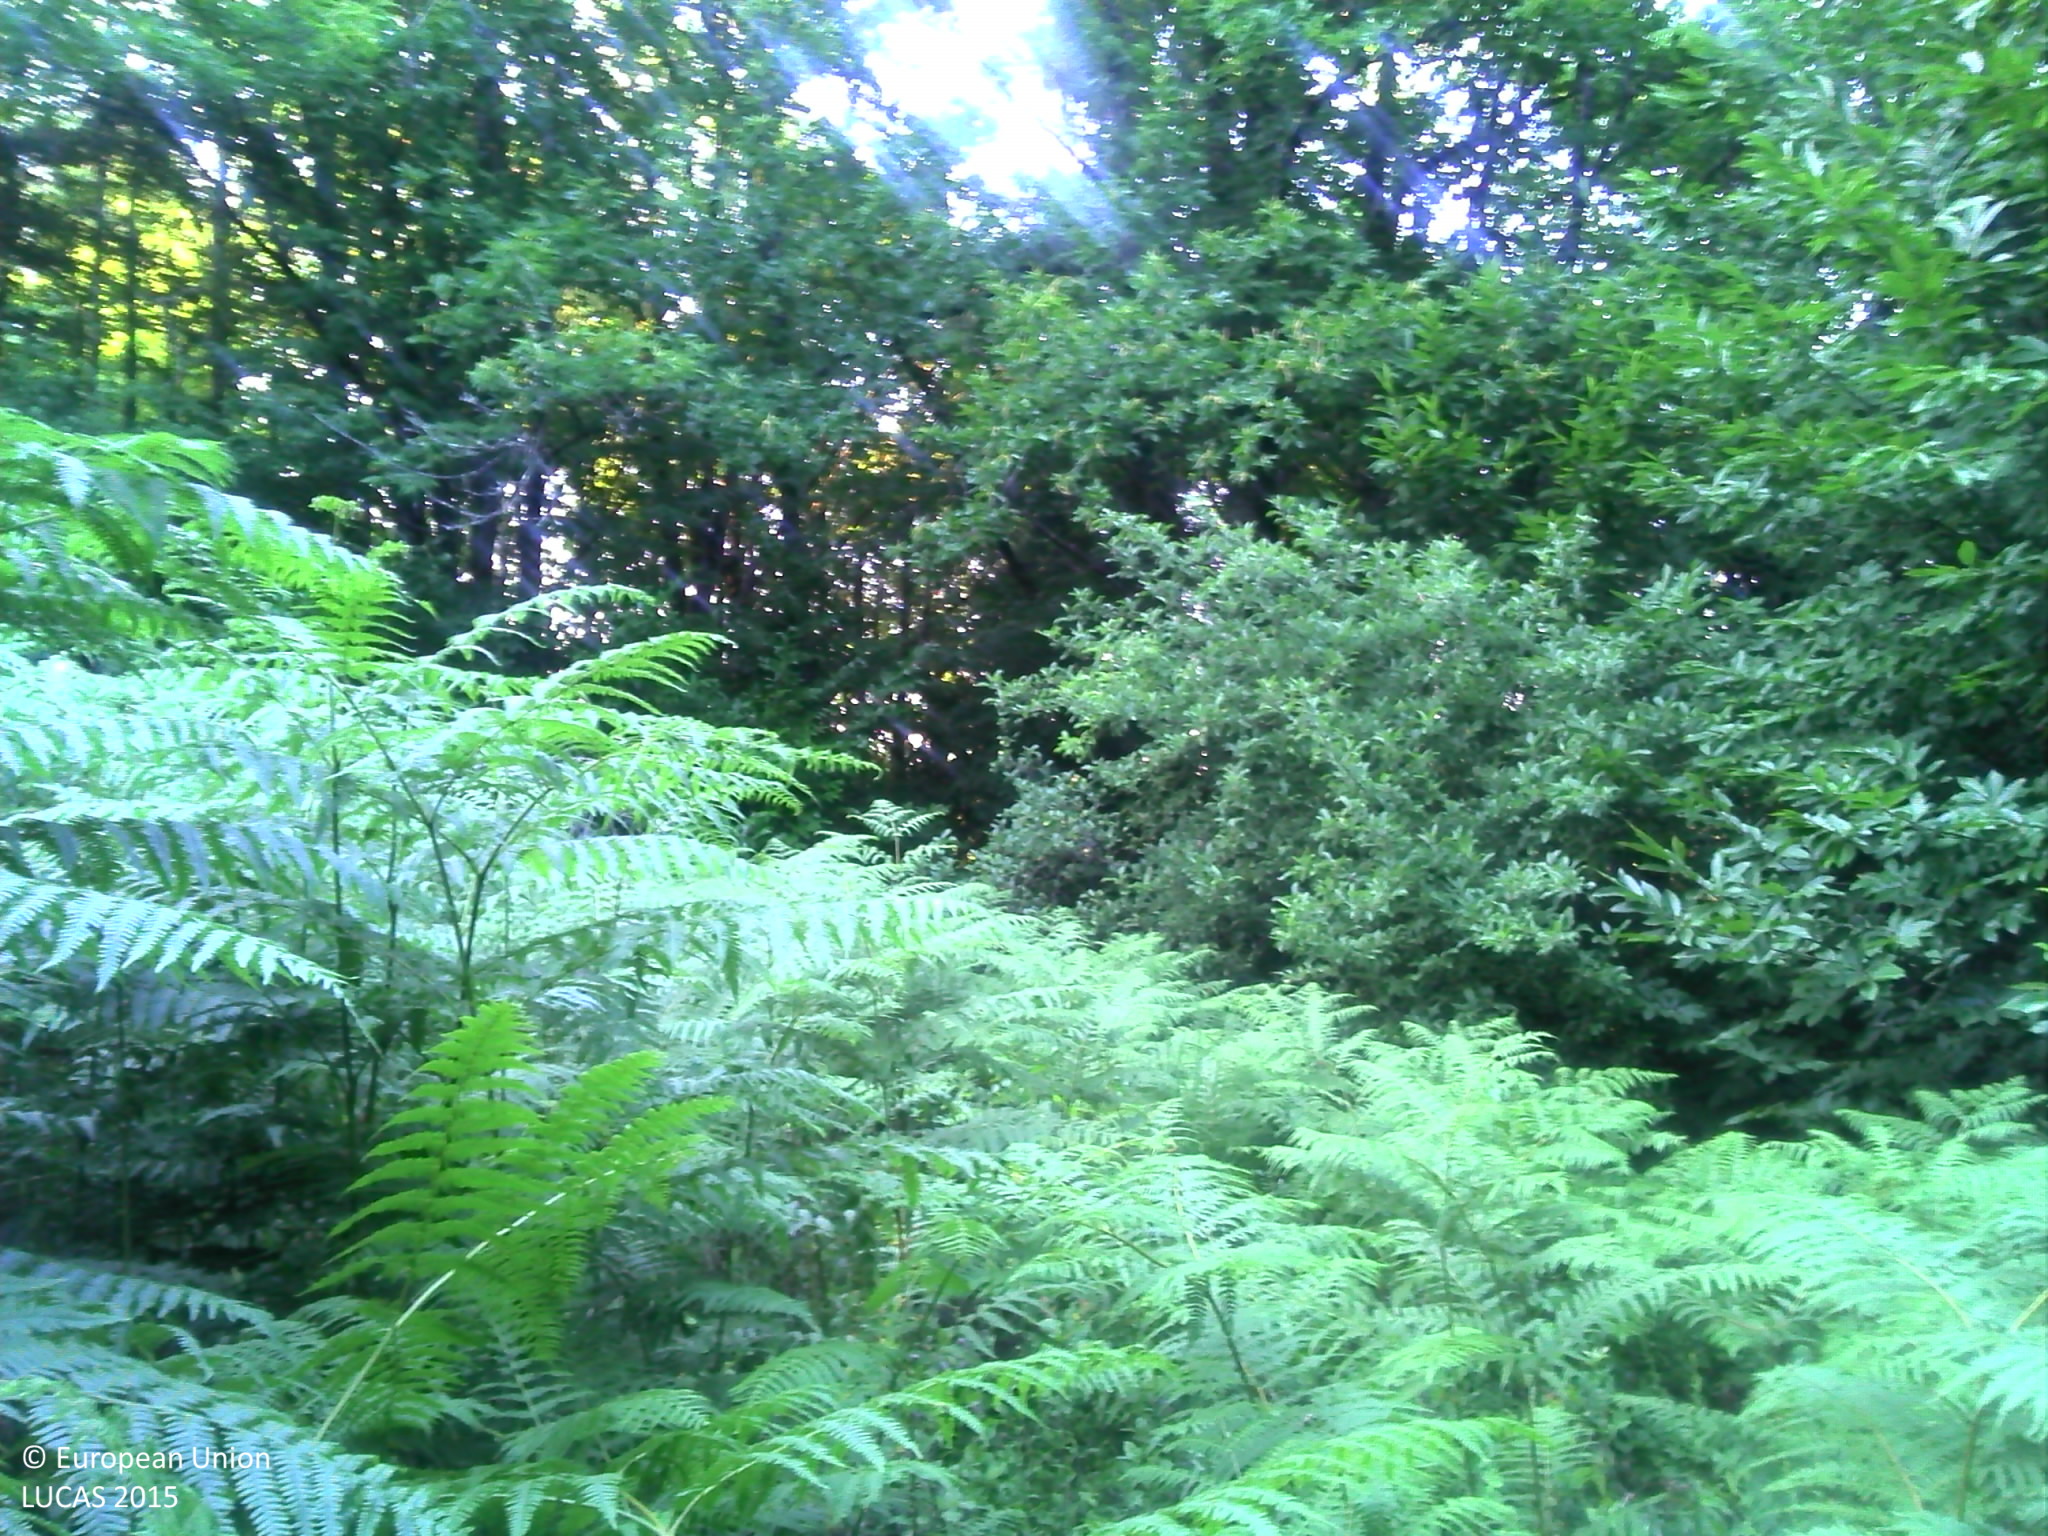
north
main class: Cropland
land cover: Apple fruit
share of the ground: 25 - 50 %
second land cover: Spontaneously vegetated surfaces
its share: 50 - 75 %
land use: Abandoned areas
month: July
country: FR
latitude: 45.9475
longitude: 1.5943
